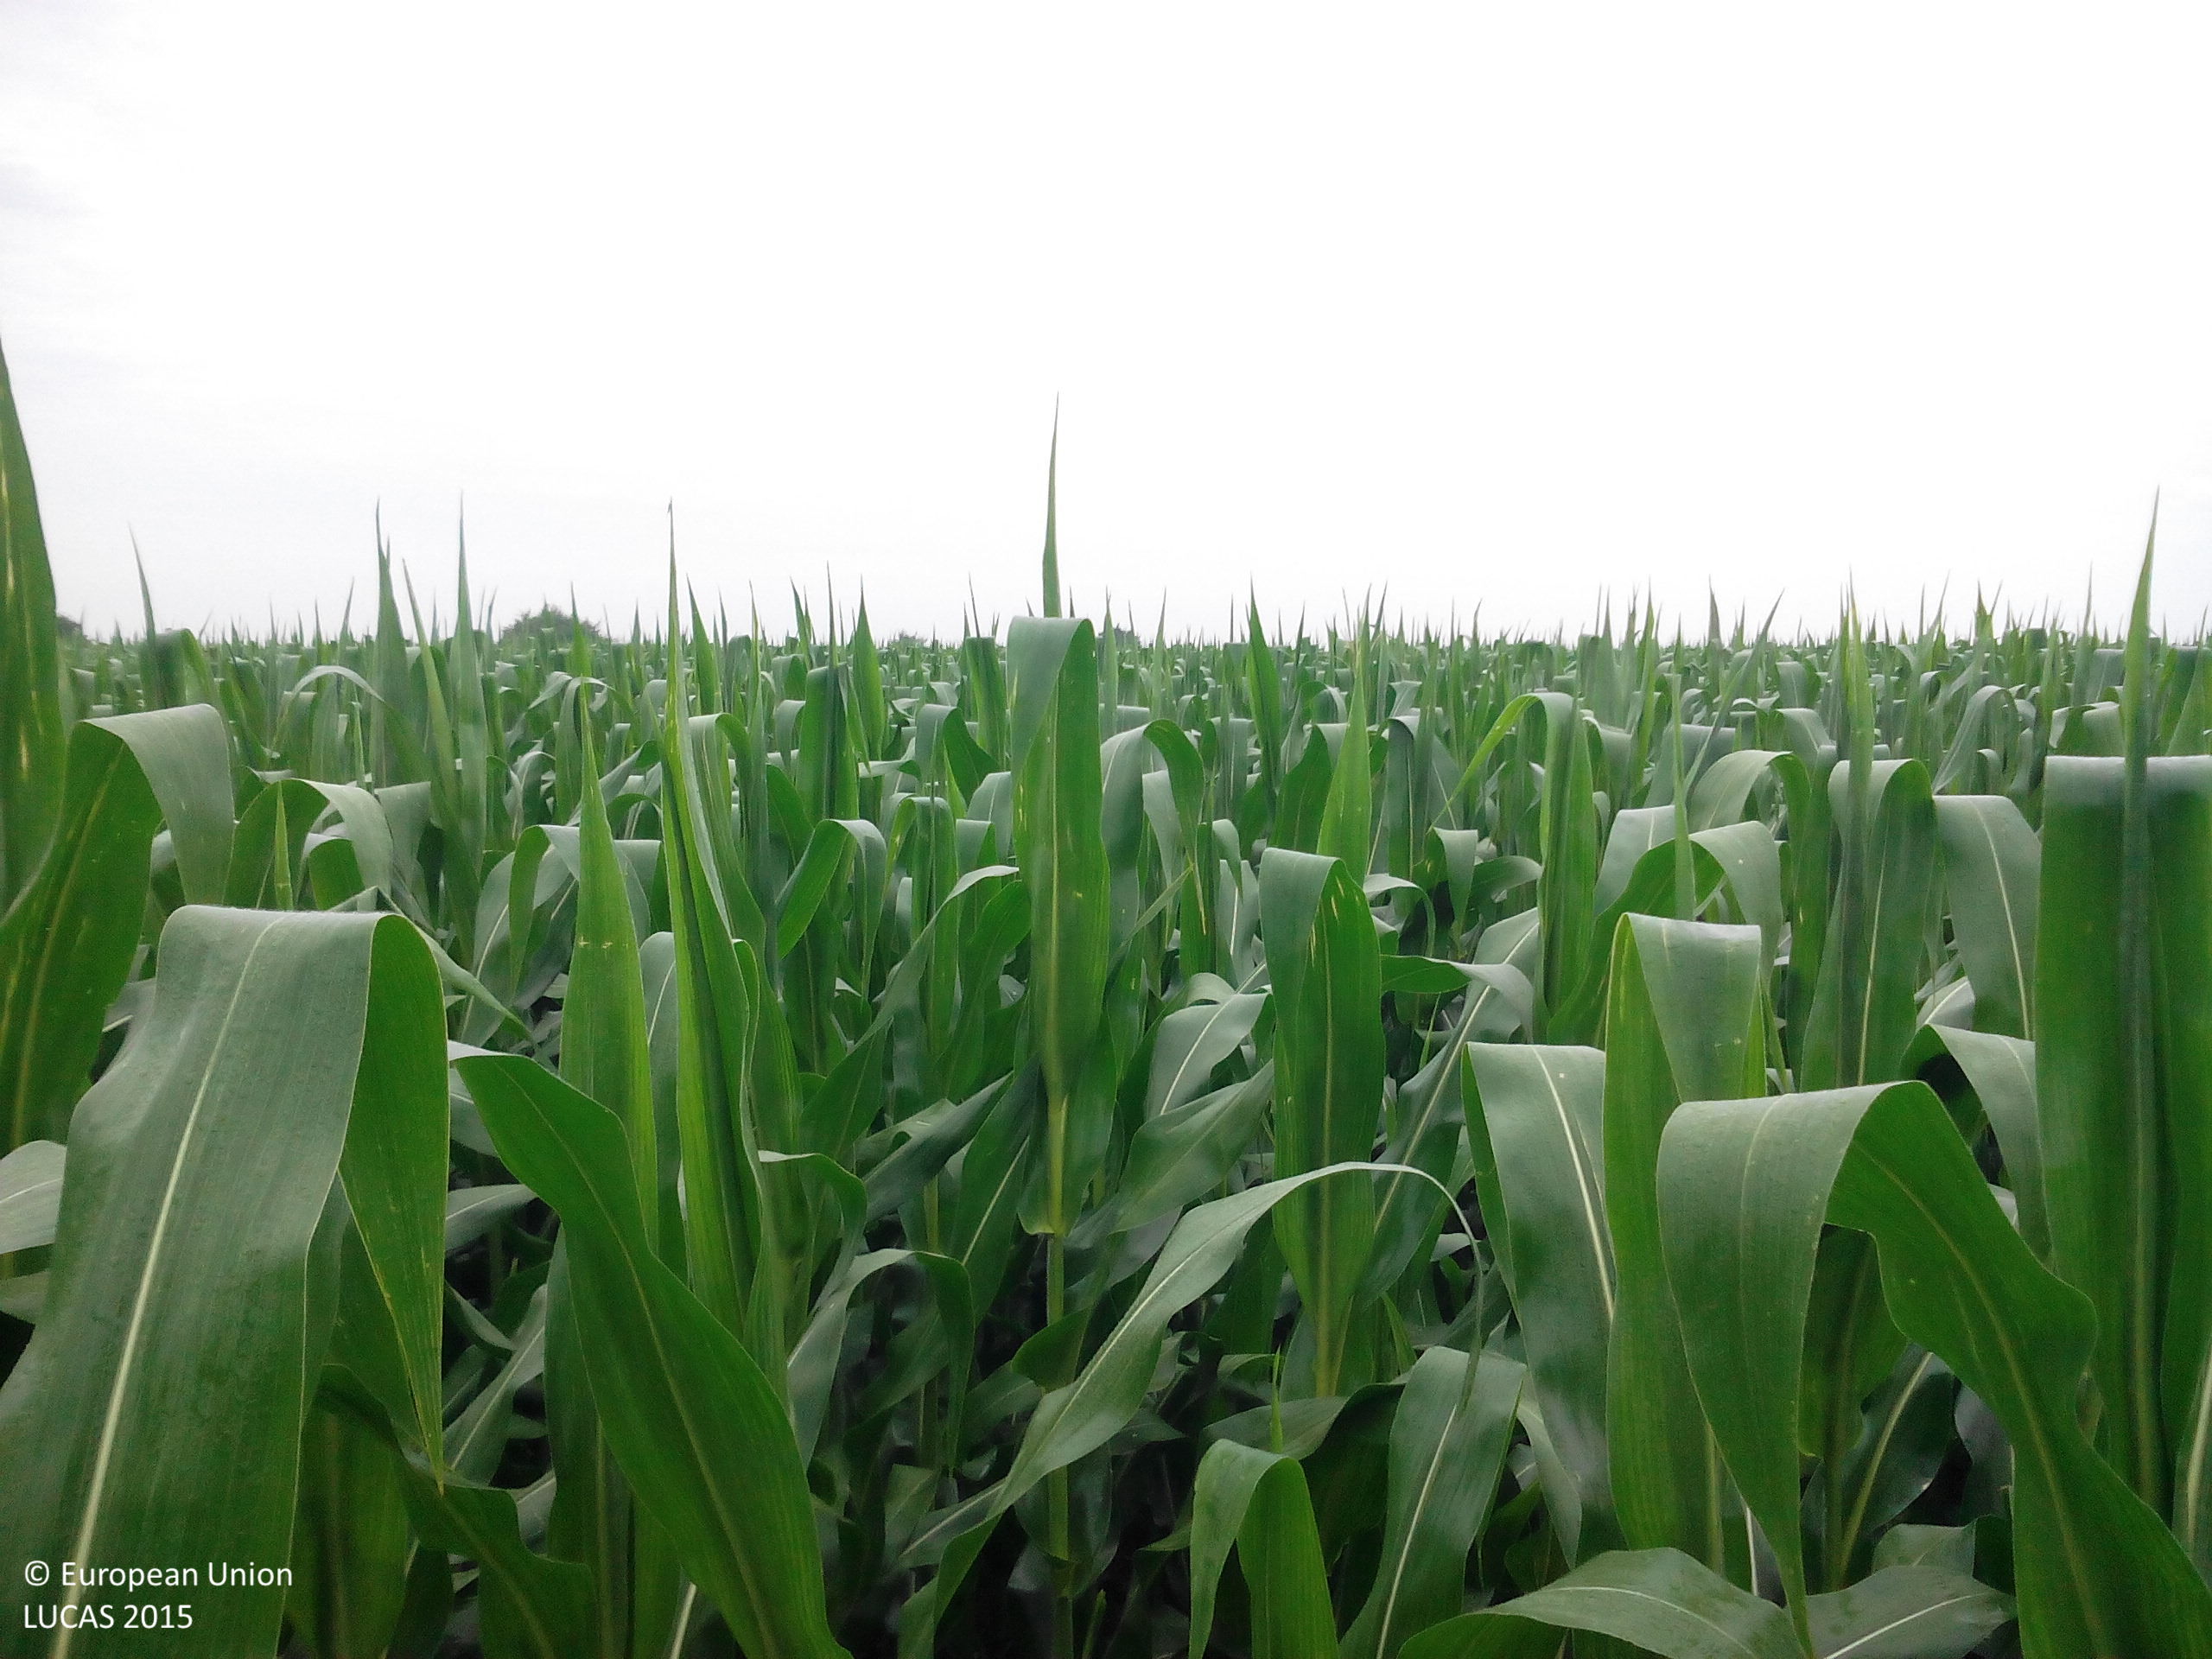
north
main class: Cropland
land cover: Maize
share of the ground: > 75 %
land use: Agriculture (excluding fallow land and kitchen gardens)
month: July
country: BG
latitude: 43.4689
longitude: 24.1341
